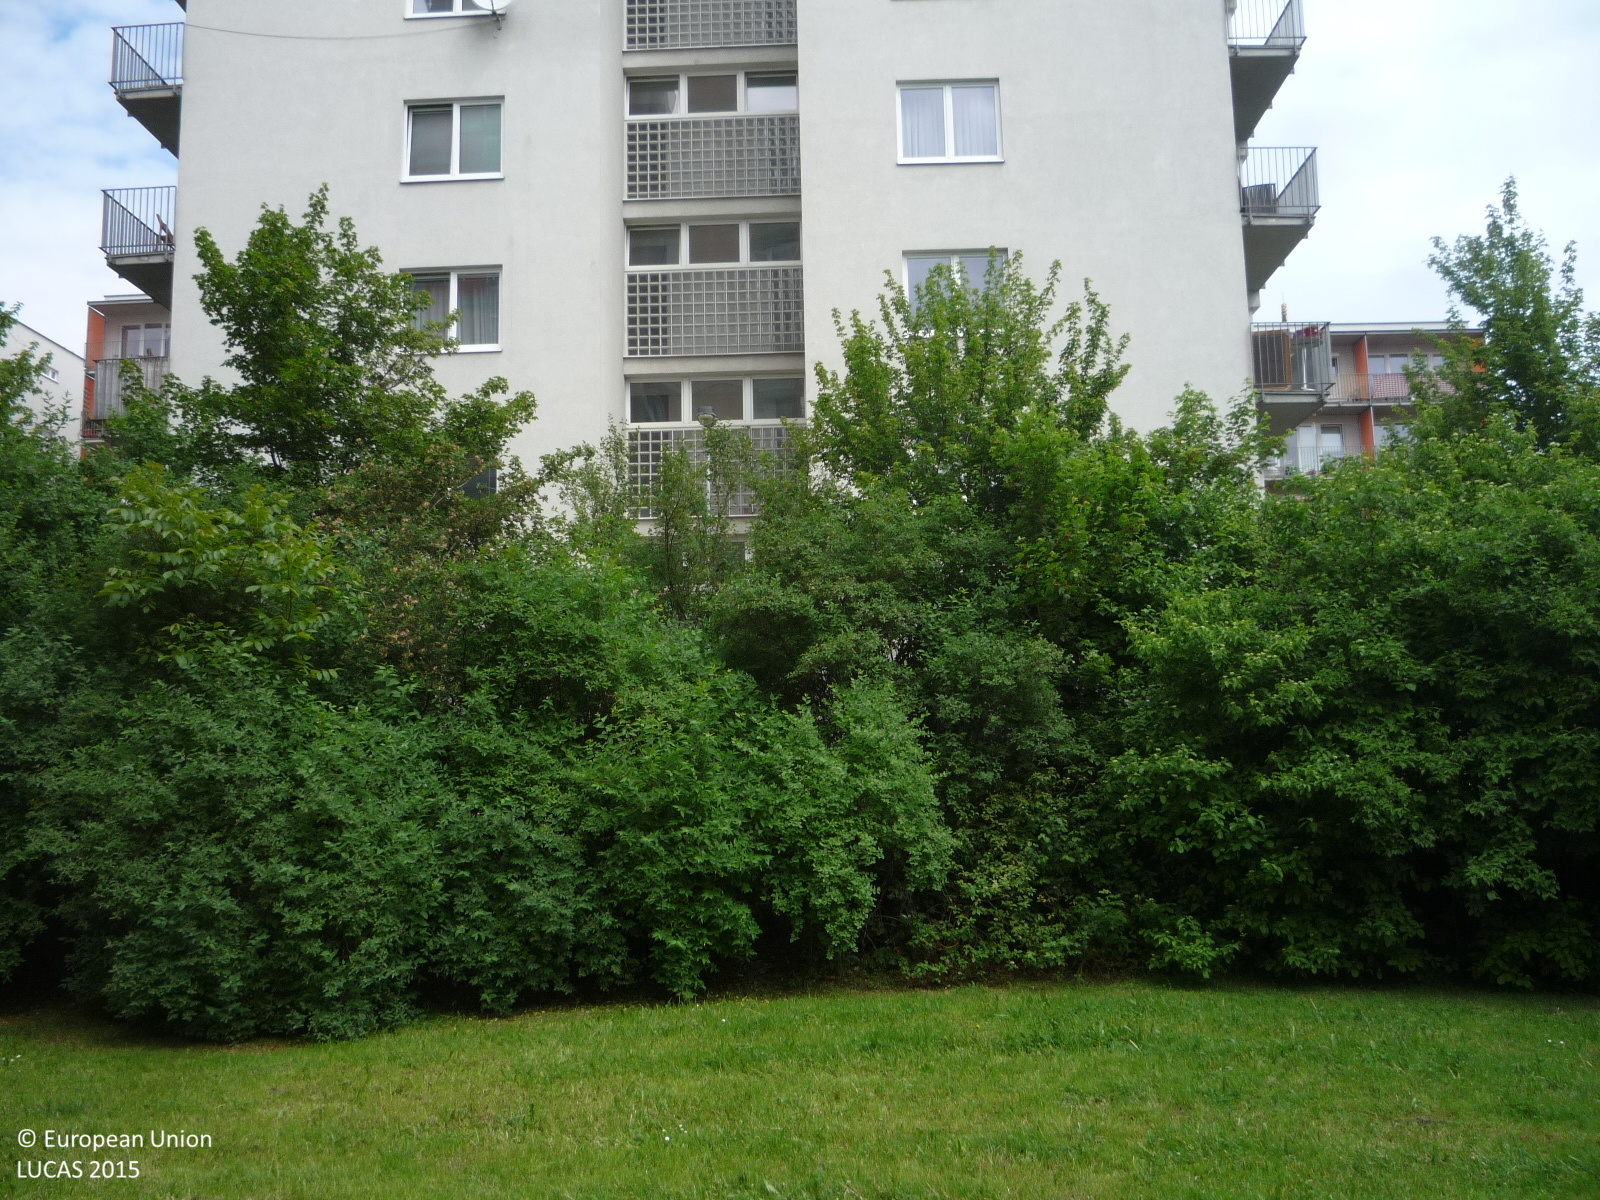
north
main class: Grassland
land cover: Grassland with sparse tree/shrub cover
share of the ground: > 75 %
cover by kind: herbaceous plants 90 %, broadleaved forest trees 5 %, shrubs 5 %
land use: Residential
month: May
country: CZ
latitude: 50.0780
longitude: 14.4873
